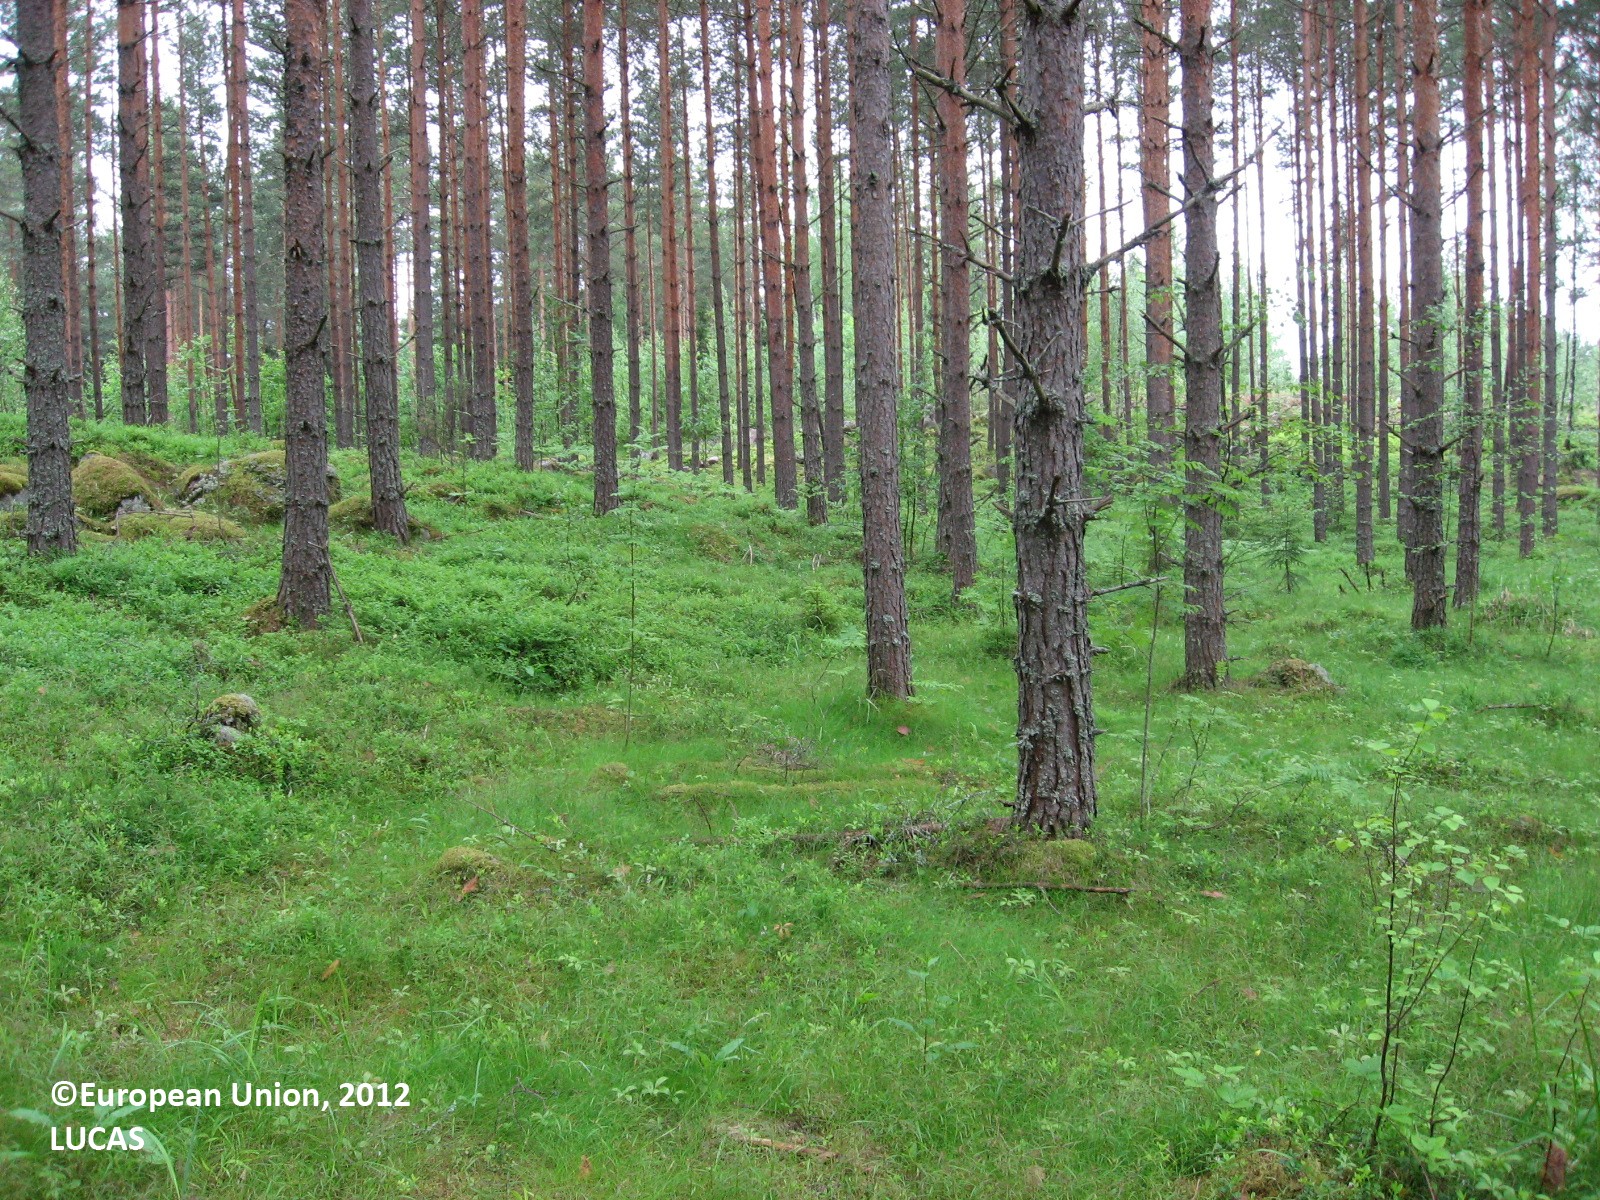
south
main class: Woodland
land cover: Pine dominated coniferous woodland
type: boreal forest
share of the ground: > 75 %
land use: Forestry
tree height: > 5 m
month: June
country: FI
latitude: 60.4825
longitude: 26.2524
